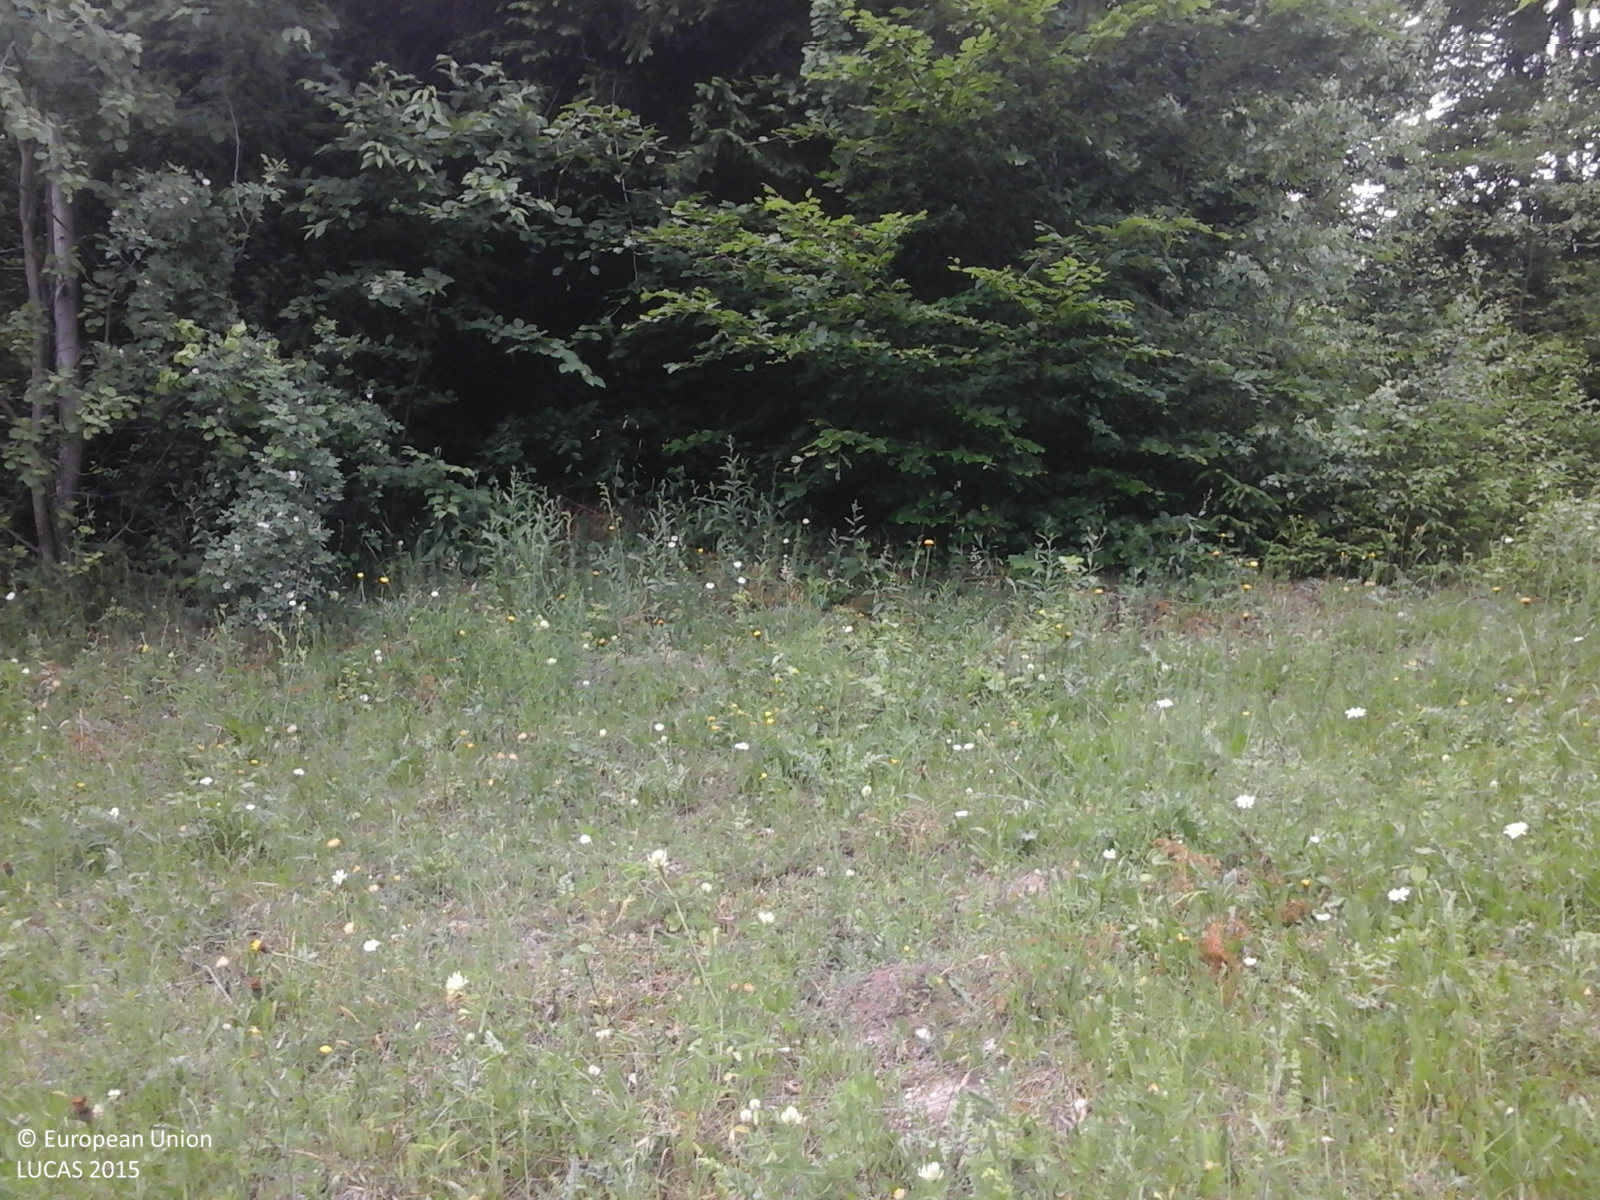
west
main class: Woodland
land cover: Spruce dominated mixed woodland
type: alpine coniferous forest
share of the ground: 50 - 75 %
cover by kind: coniferous forest trees 75 %, broadleaved forest trees 25 %
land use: Forestry
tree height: > 5 m
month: June
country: RO
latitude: 47.6480
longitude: 25.7659
